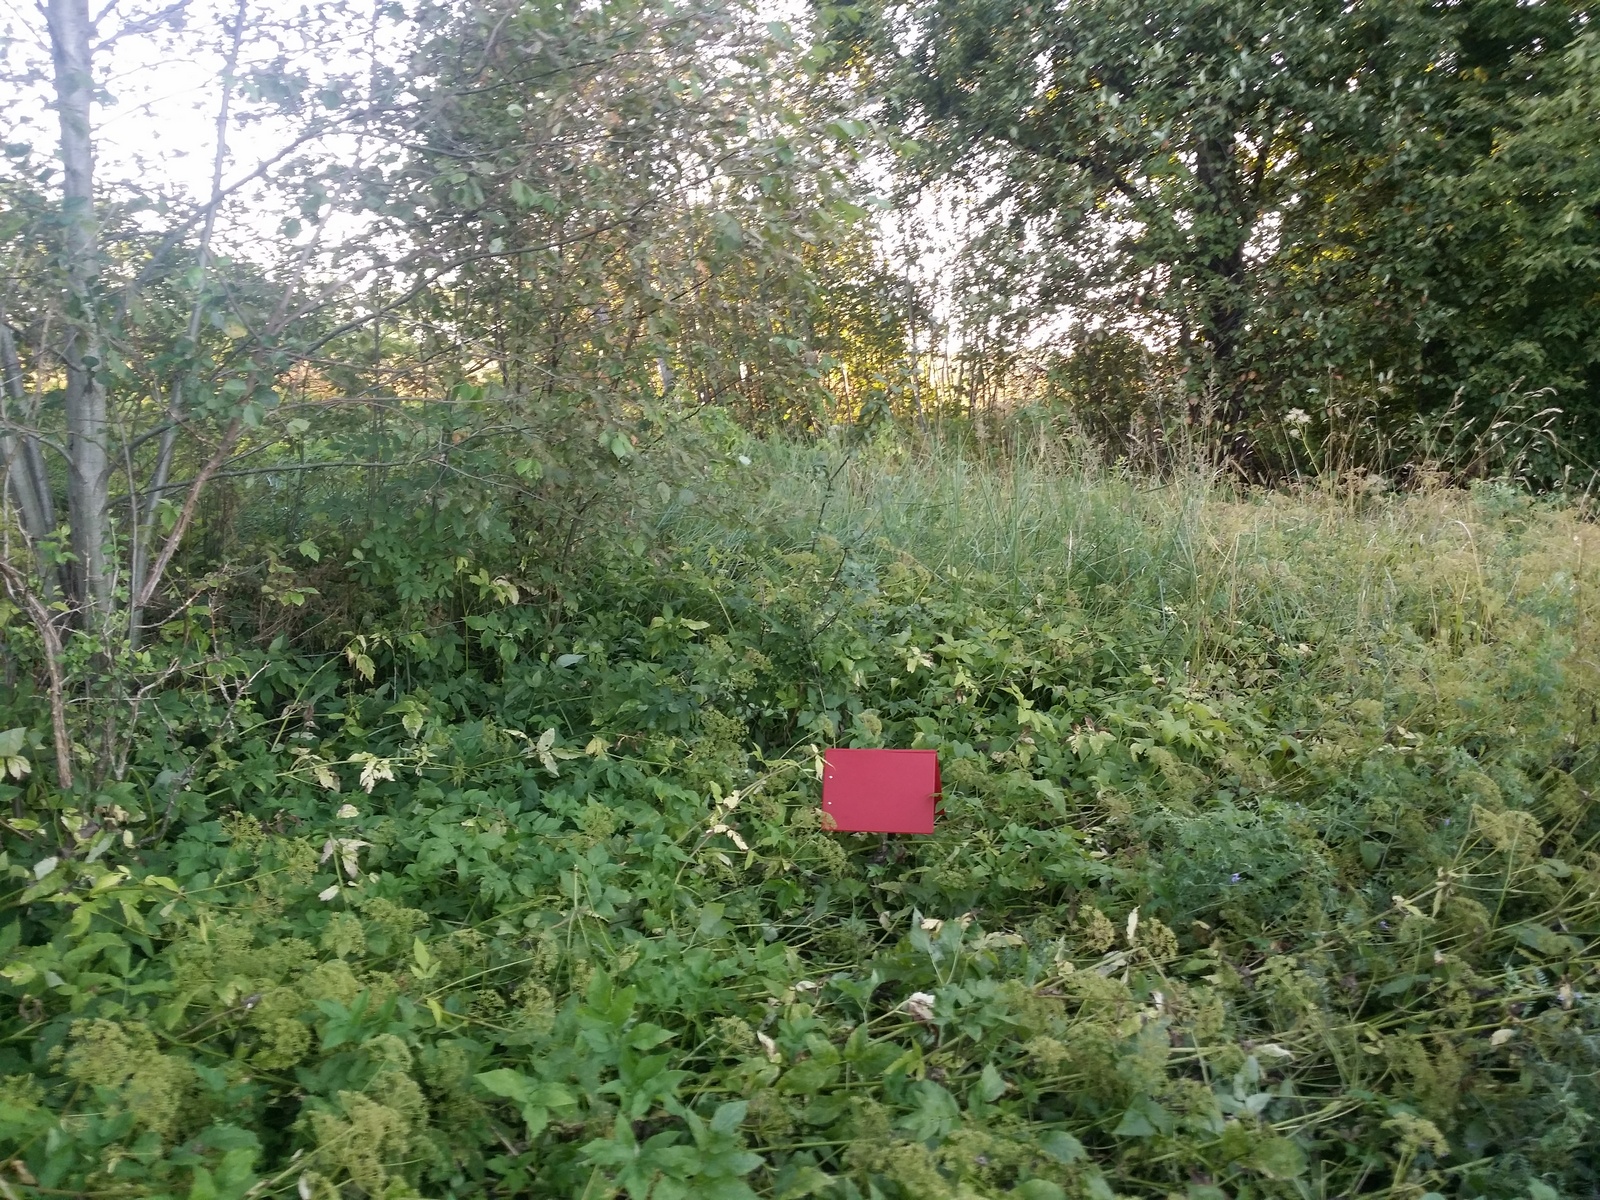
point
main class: Grassland
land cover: Spontaneously vegetated surfaces
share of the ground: > 75 %
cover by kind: herbaceous plants 95 %, shrubs 5 %
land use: Semi-natural and natural areas not in use
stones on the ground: < 10 %
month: August
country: LV
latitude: 57.1543
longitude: 26.7663
